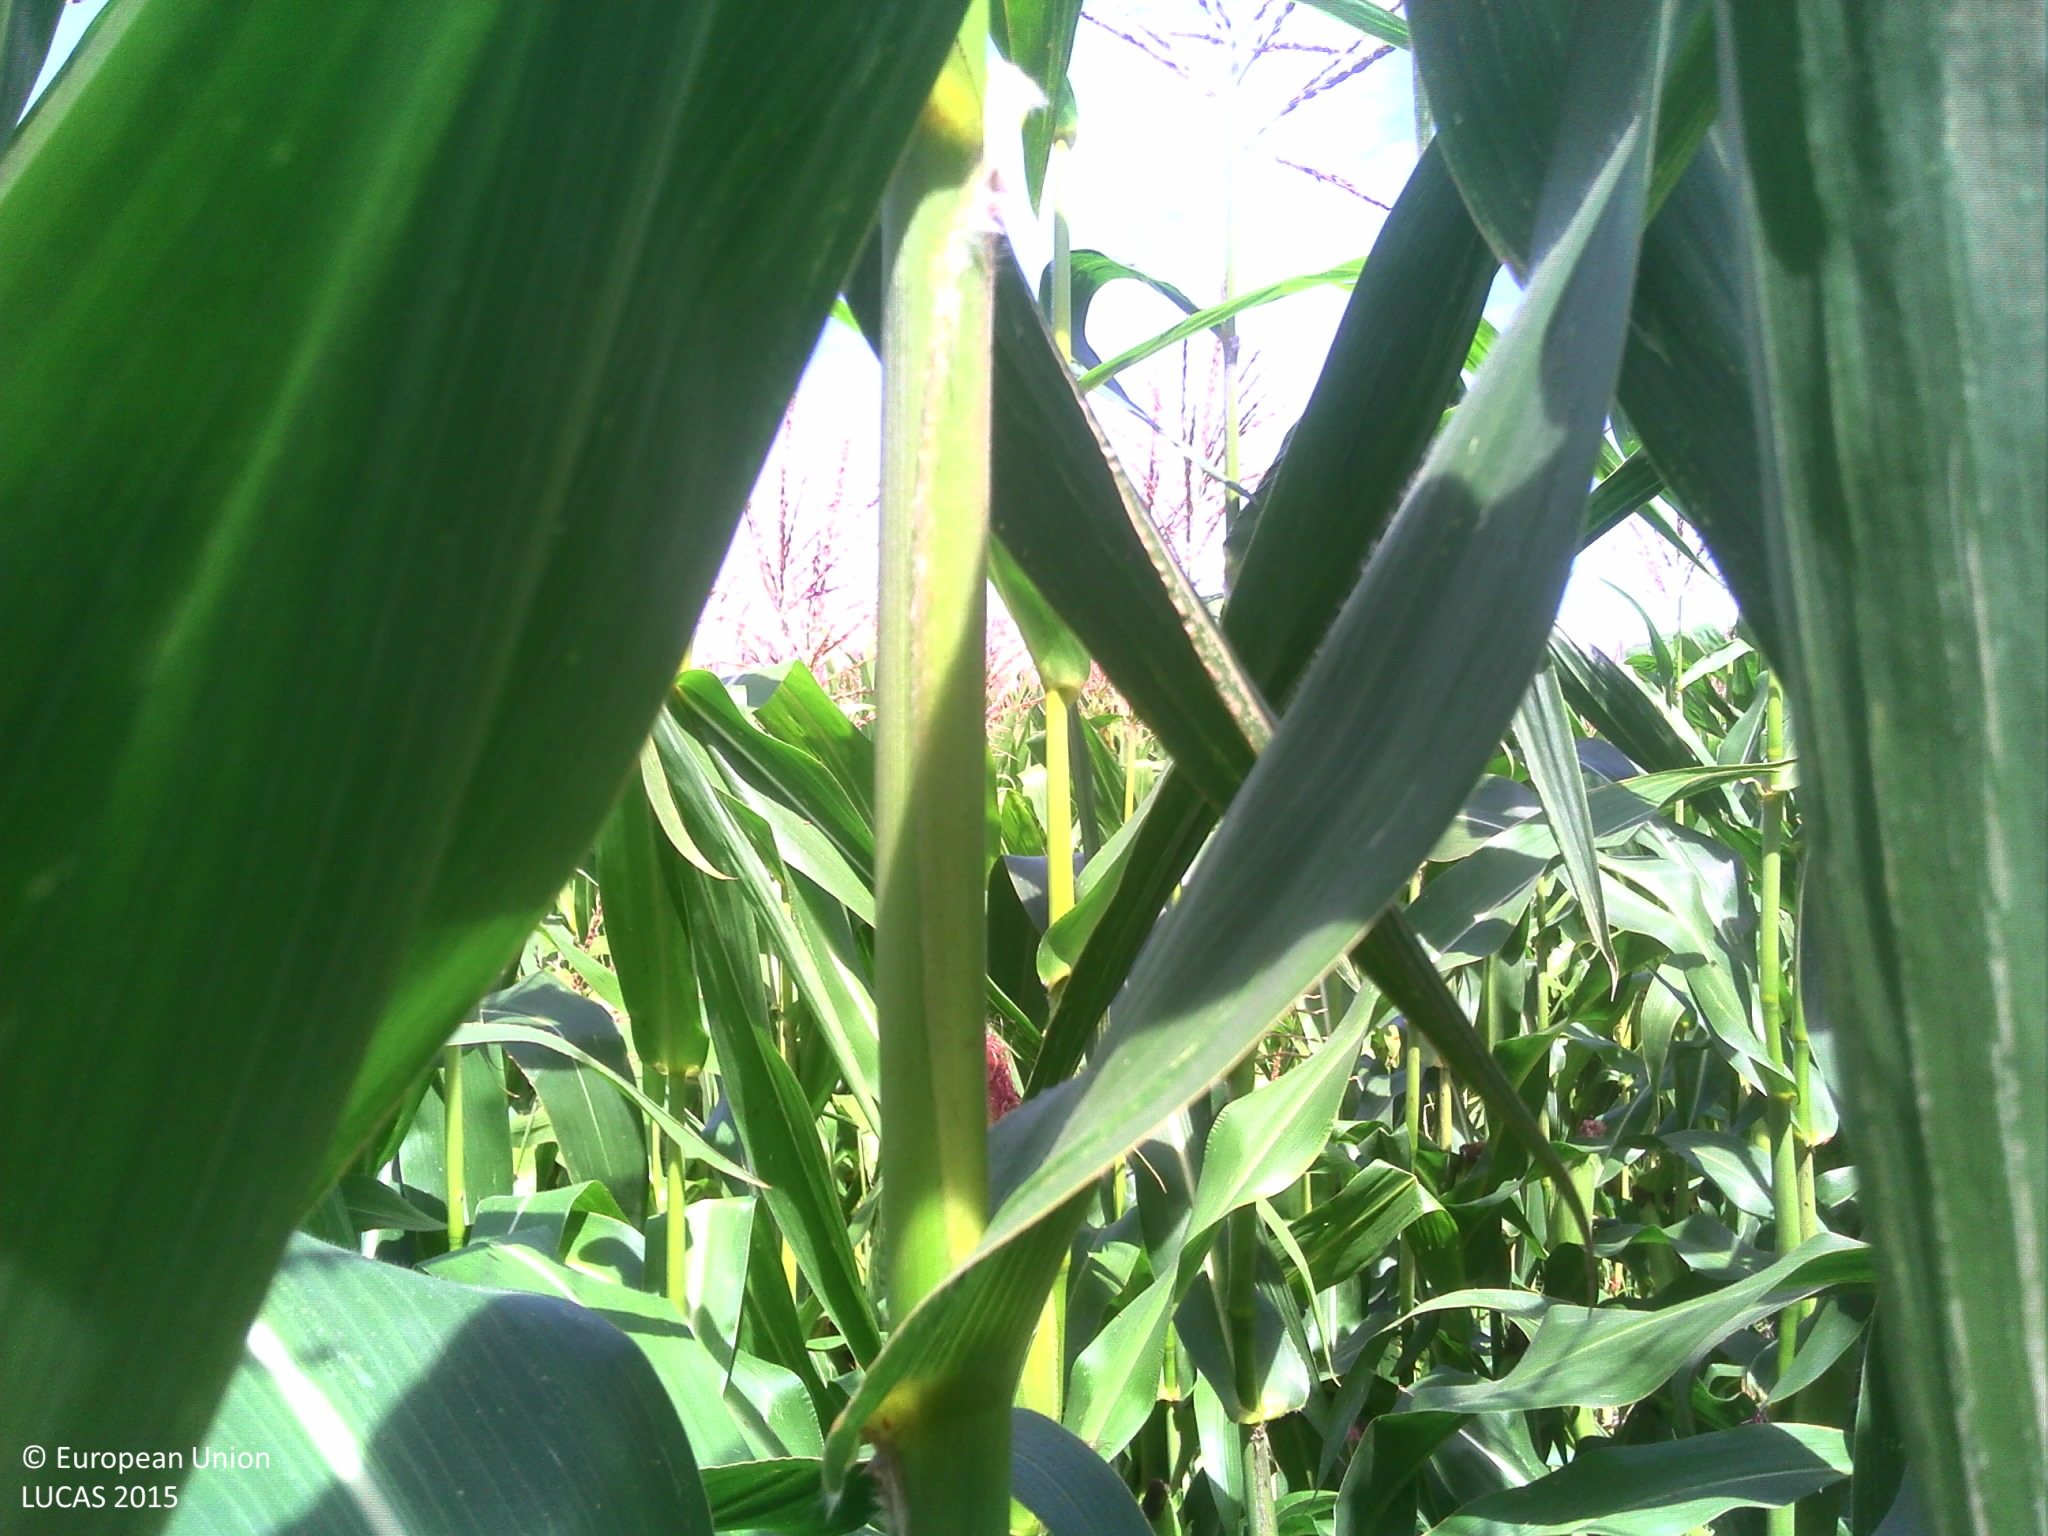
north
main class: Cropland
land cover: Maize
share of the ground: > 75 %
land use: Agriculture (excluding fallow land and kitchen gardens)
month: August
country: FR
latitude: 46.7665
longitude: -1.6558
